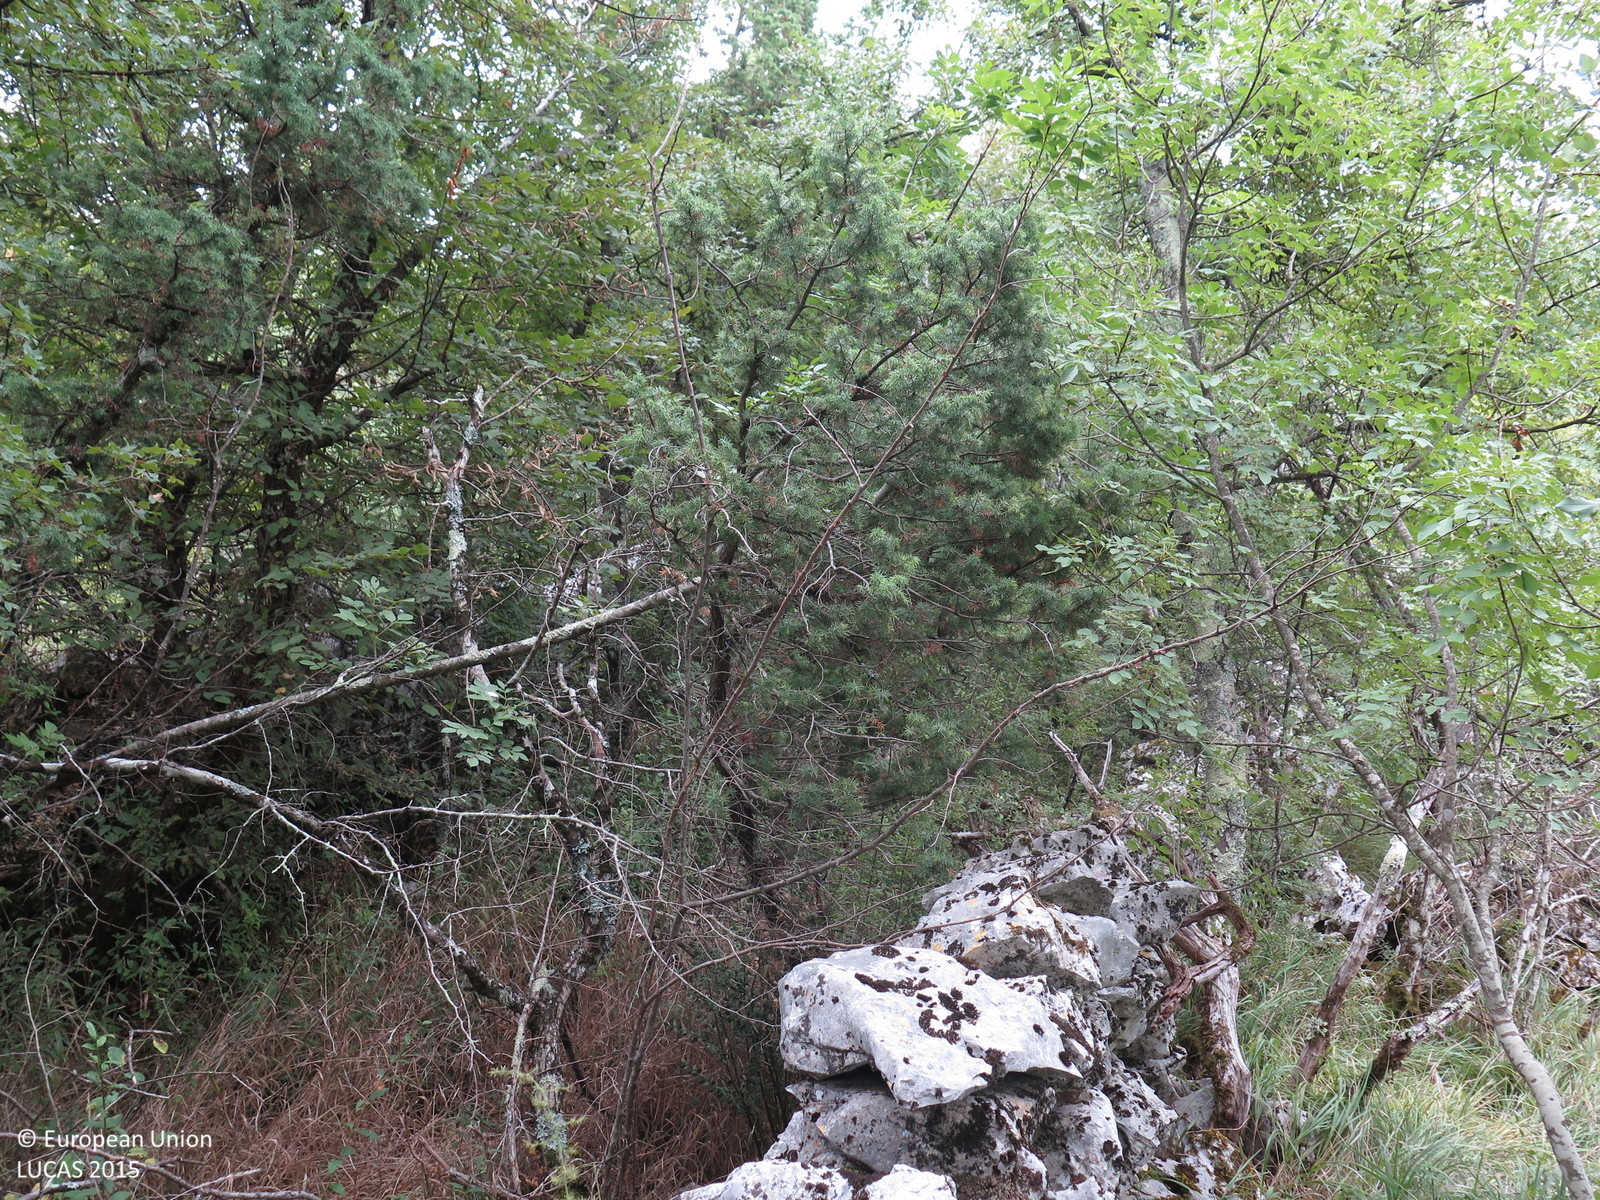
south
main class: Woodland
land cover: Broadleaved woodland
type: thermophilous deciduous forest
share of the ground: > 75 %
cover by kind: broadleaved forest trees 90 %, shrubs 5 %, herbaceous plants 5 %
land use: Semi-natural and natural areas not in use
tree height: > 5 m
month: August
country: HR
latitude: 45.1330
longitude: 14.6102
